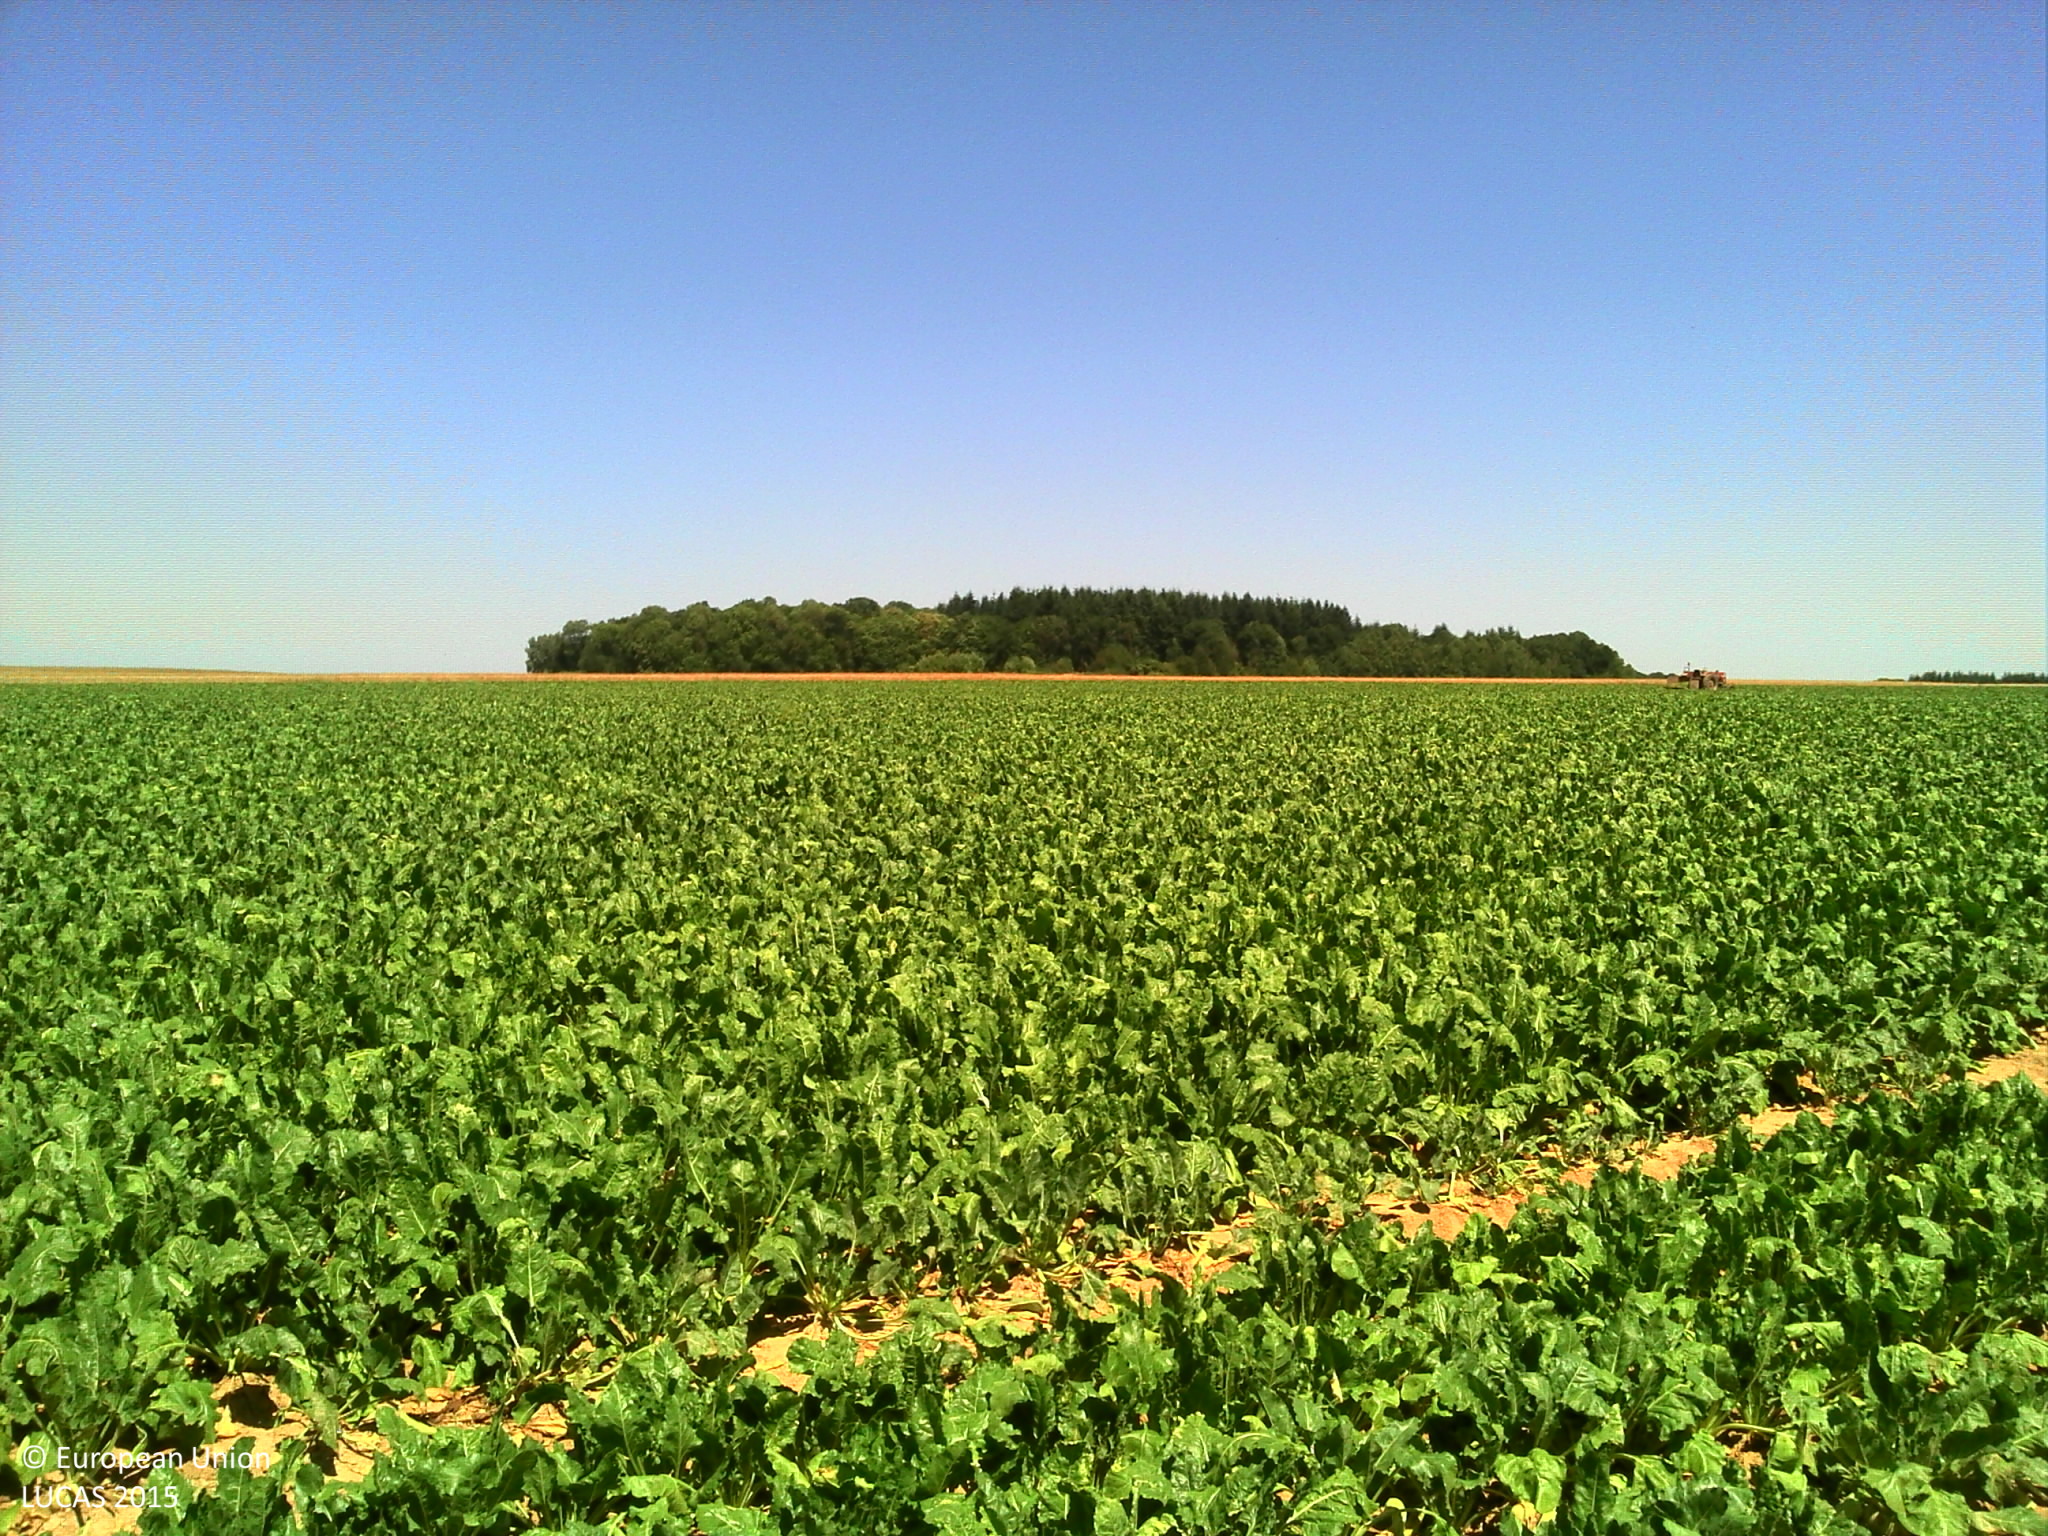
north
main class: Cropland
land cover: Sugar beet
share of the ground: > 75 %
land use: Agriculture (excluding fallow land and kitchen gardens)
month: July
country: FR
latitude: 49.2227
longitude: 1.8422
